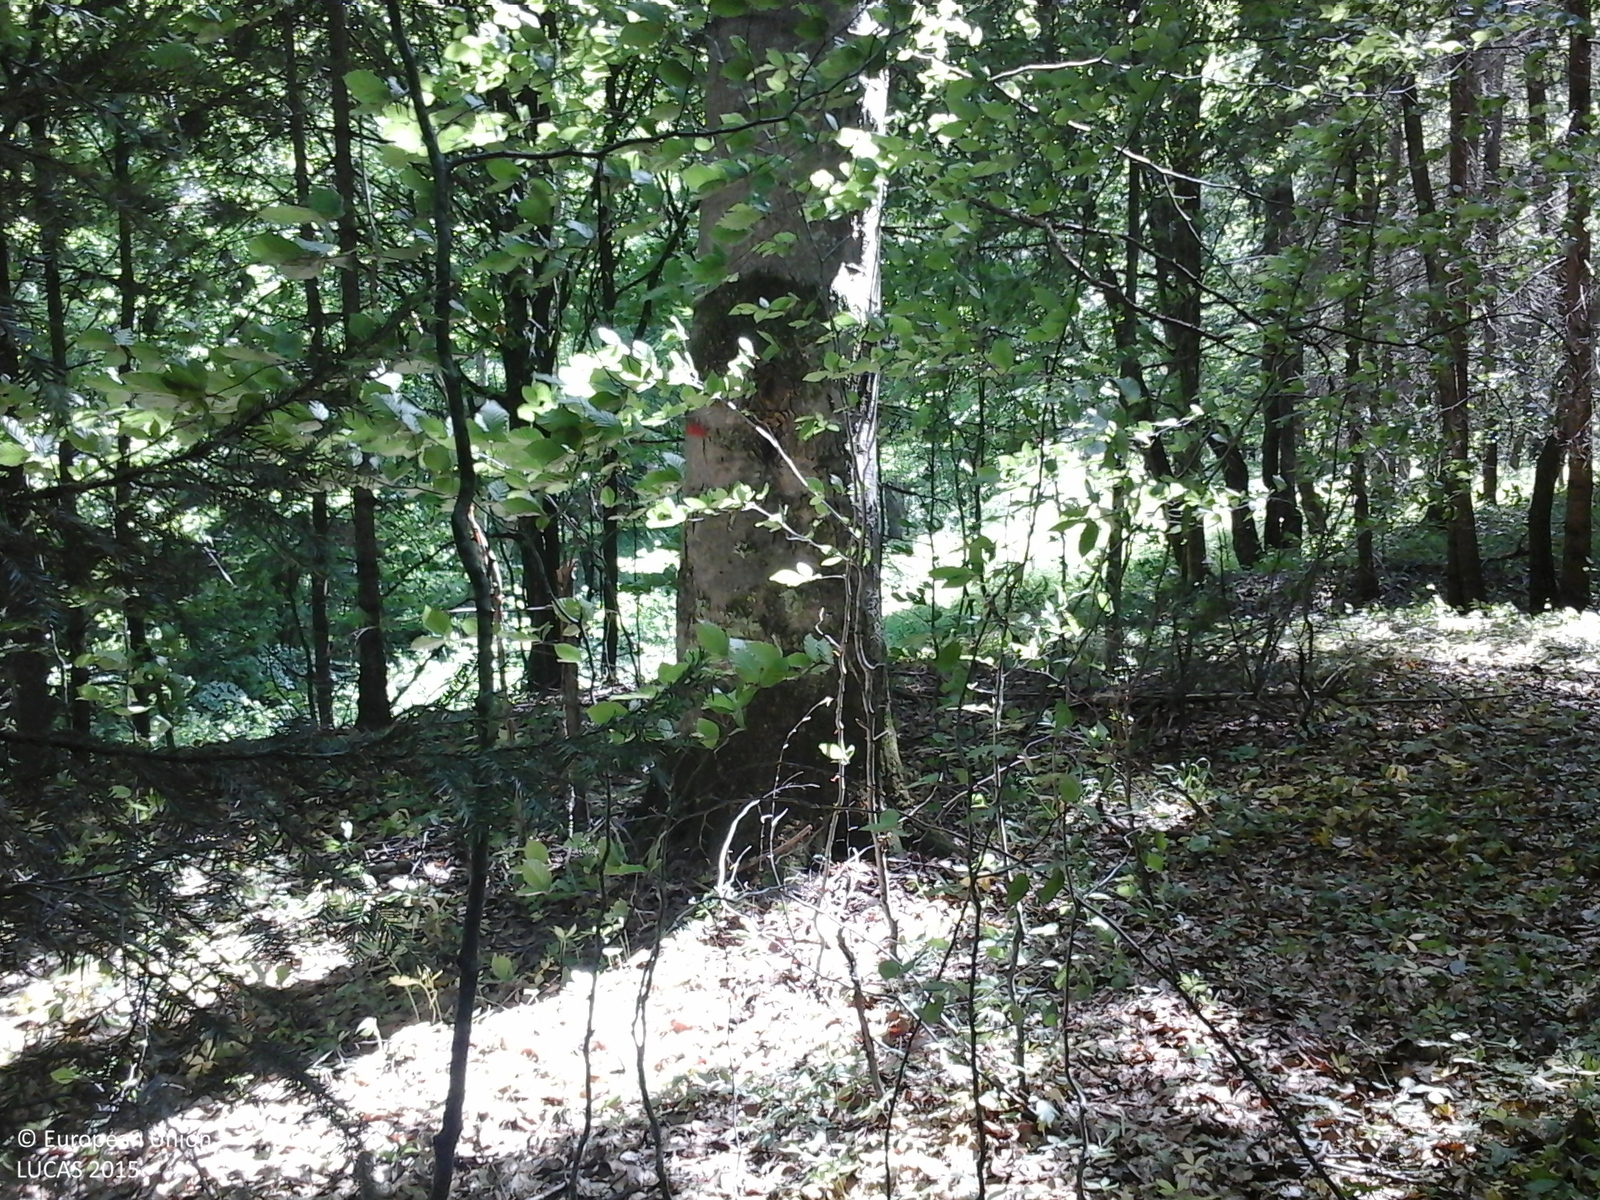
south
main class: Woodland
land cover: Spruce dominated mixed woodland
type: hemiboreal forest and nemoral coniferous forest and mixed broadleaved-coniferous forest
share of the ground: > 75 %
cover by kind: coniferous forest trees 60 %, broadleaved forest trees 40 %
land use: Forestry
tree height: > 5 m
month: May
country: RO
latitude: 46.1857
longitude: 26.5745
